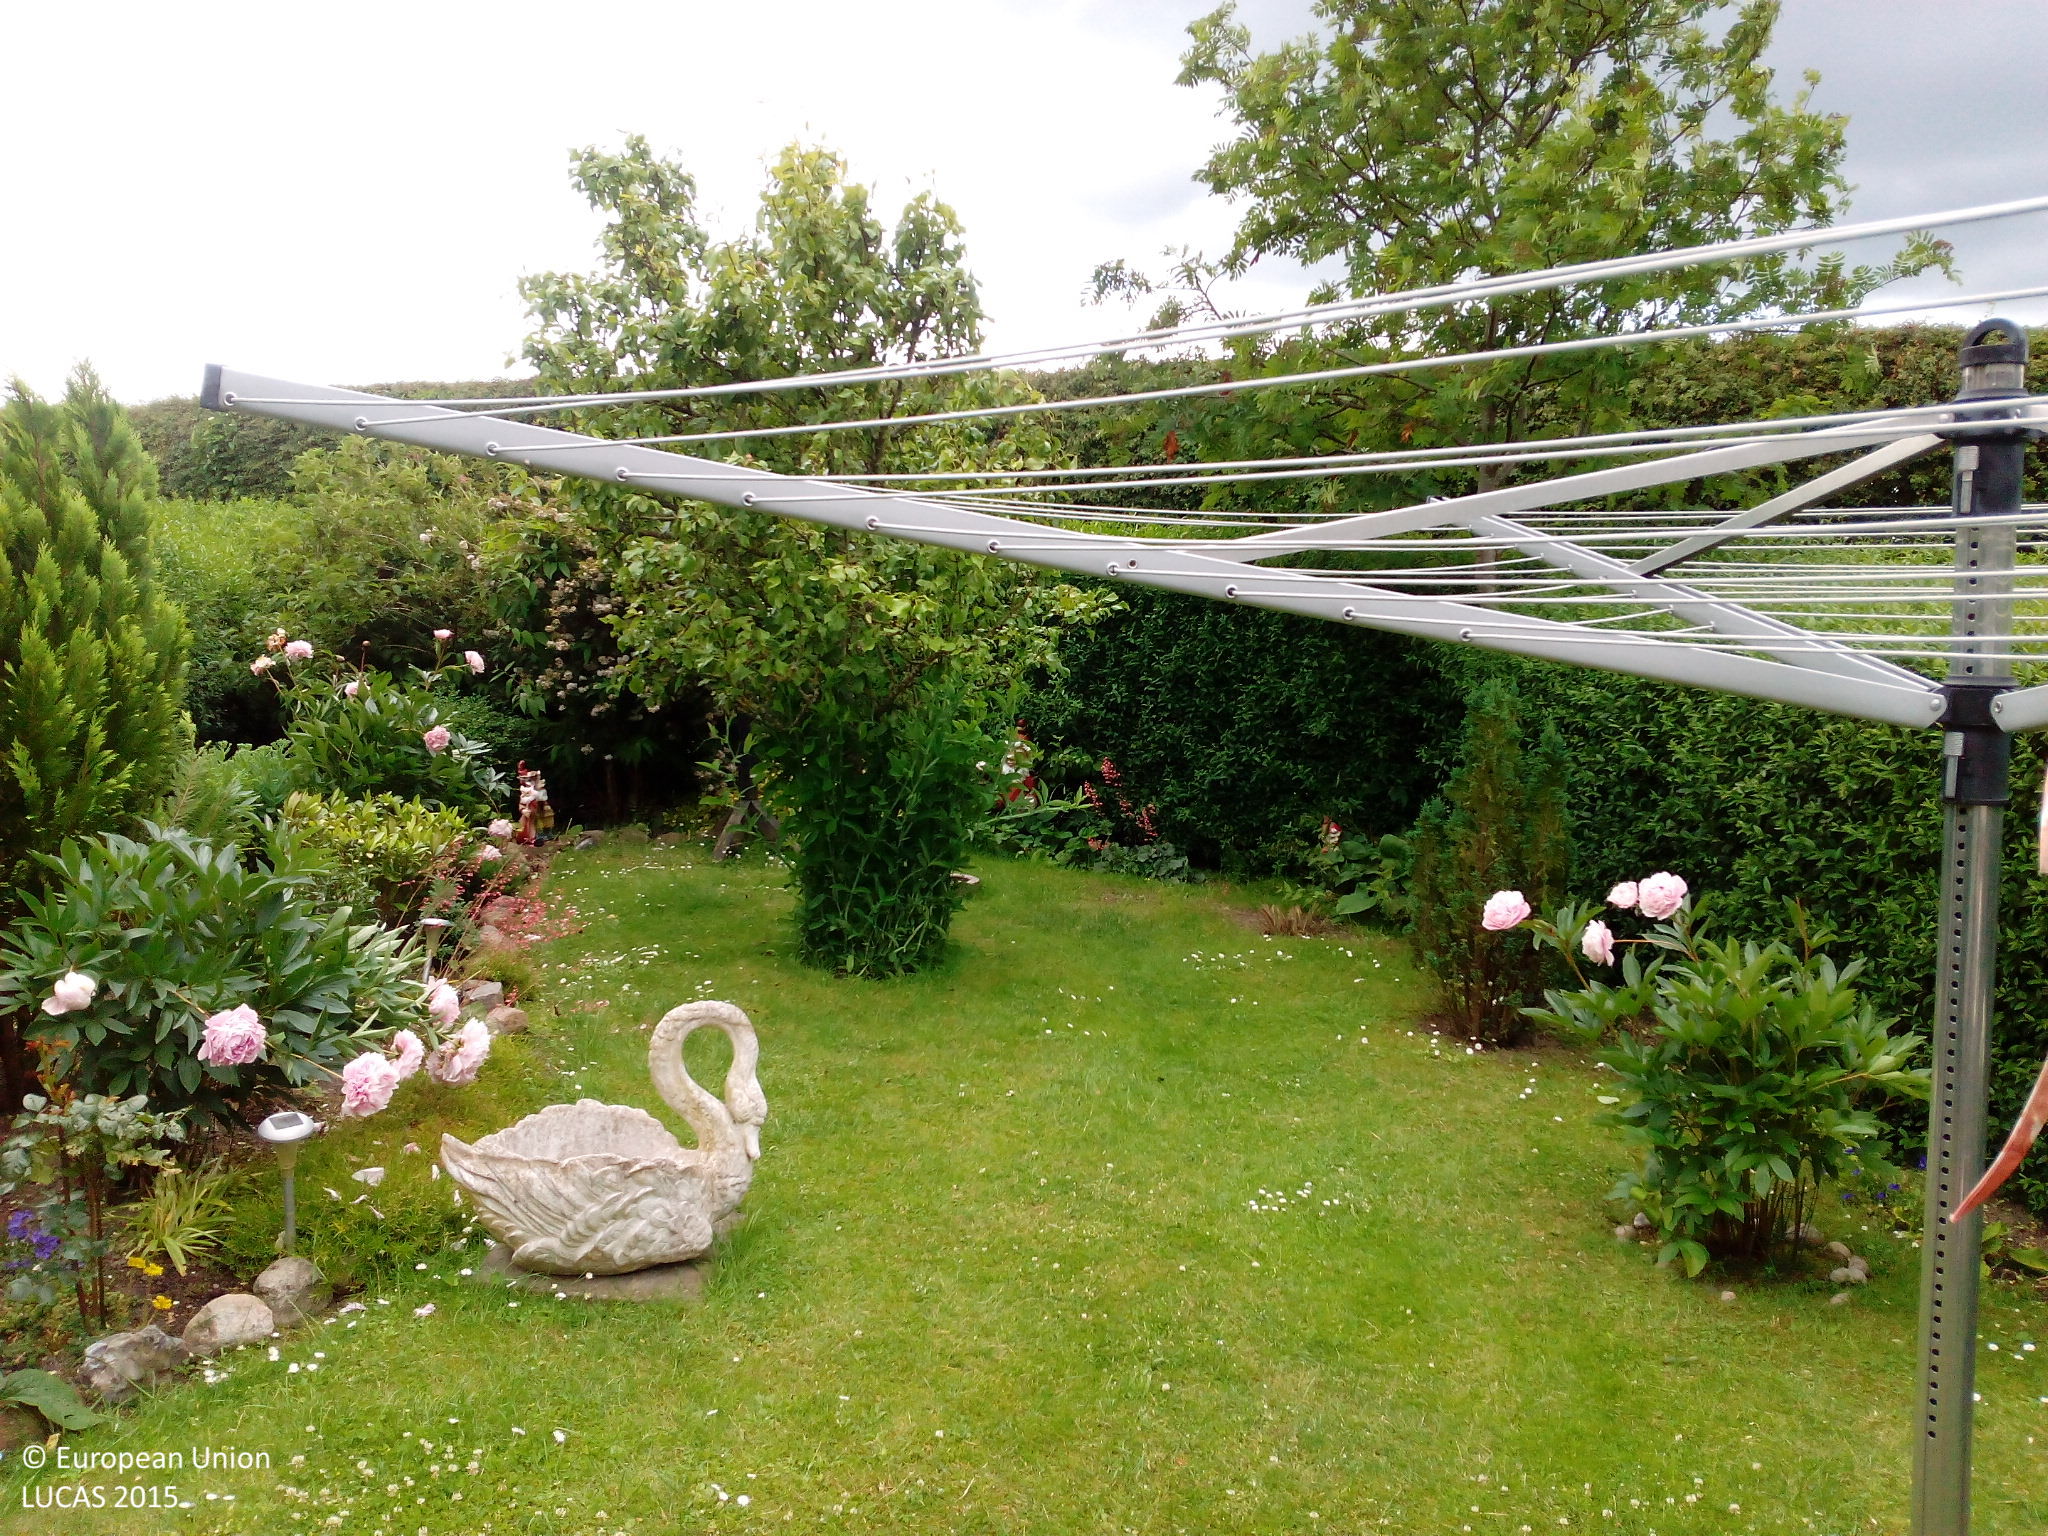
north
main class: Grassland
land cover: Grassland without tree/shrub cover
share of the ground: > 75 %
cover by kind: herbaceous plants 100 %
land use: Residential
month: July
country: DK
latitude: 55.2547
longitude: 12.0281
